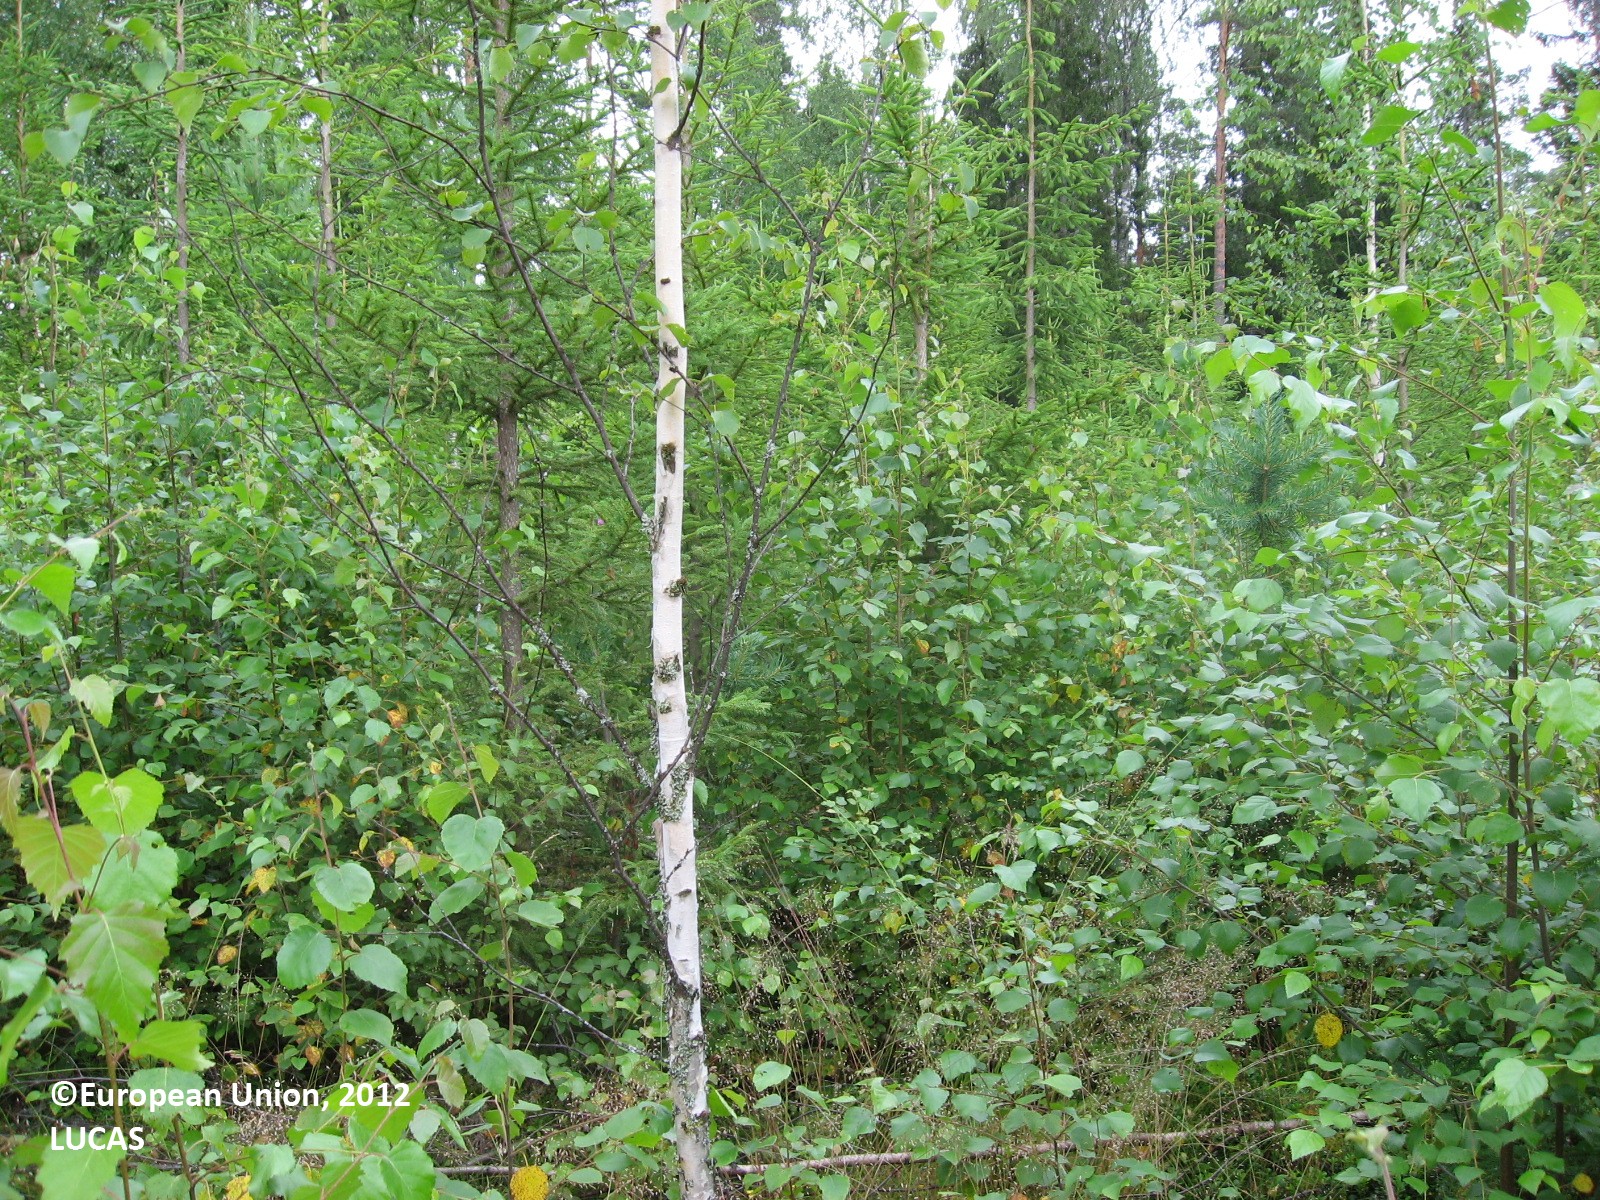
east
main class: Woodland
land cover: Spruce dominated mixed woodland
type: boreal forest
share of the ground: > 75 %
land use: Forestry
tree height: < 5 m
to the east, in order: Spruce dominated mixed woodland; Ditches and canals; Grass margins; Paved roads, cycling and walking lanes; Grass margins; Spruce dominated mixed woodland; Spruce dominated coniferous woodland; Spruce dominated mixed woodland; Spruce dominated coniferous woodland; Ditches and canals; Spruce dominated coniferous woodland; Ditches and canals; Spruce dominated coniferous woodland; Ditches and canals; Spruce dominated mixed woodland
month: July
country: FI
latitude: 61.3844
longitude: 25.9497
